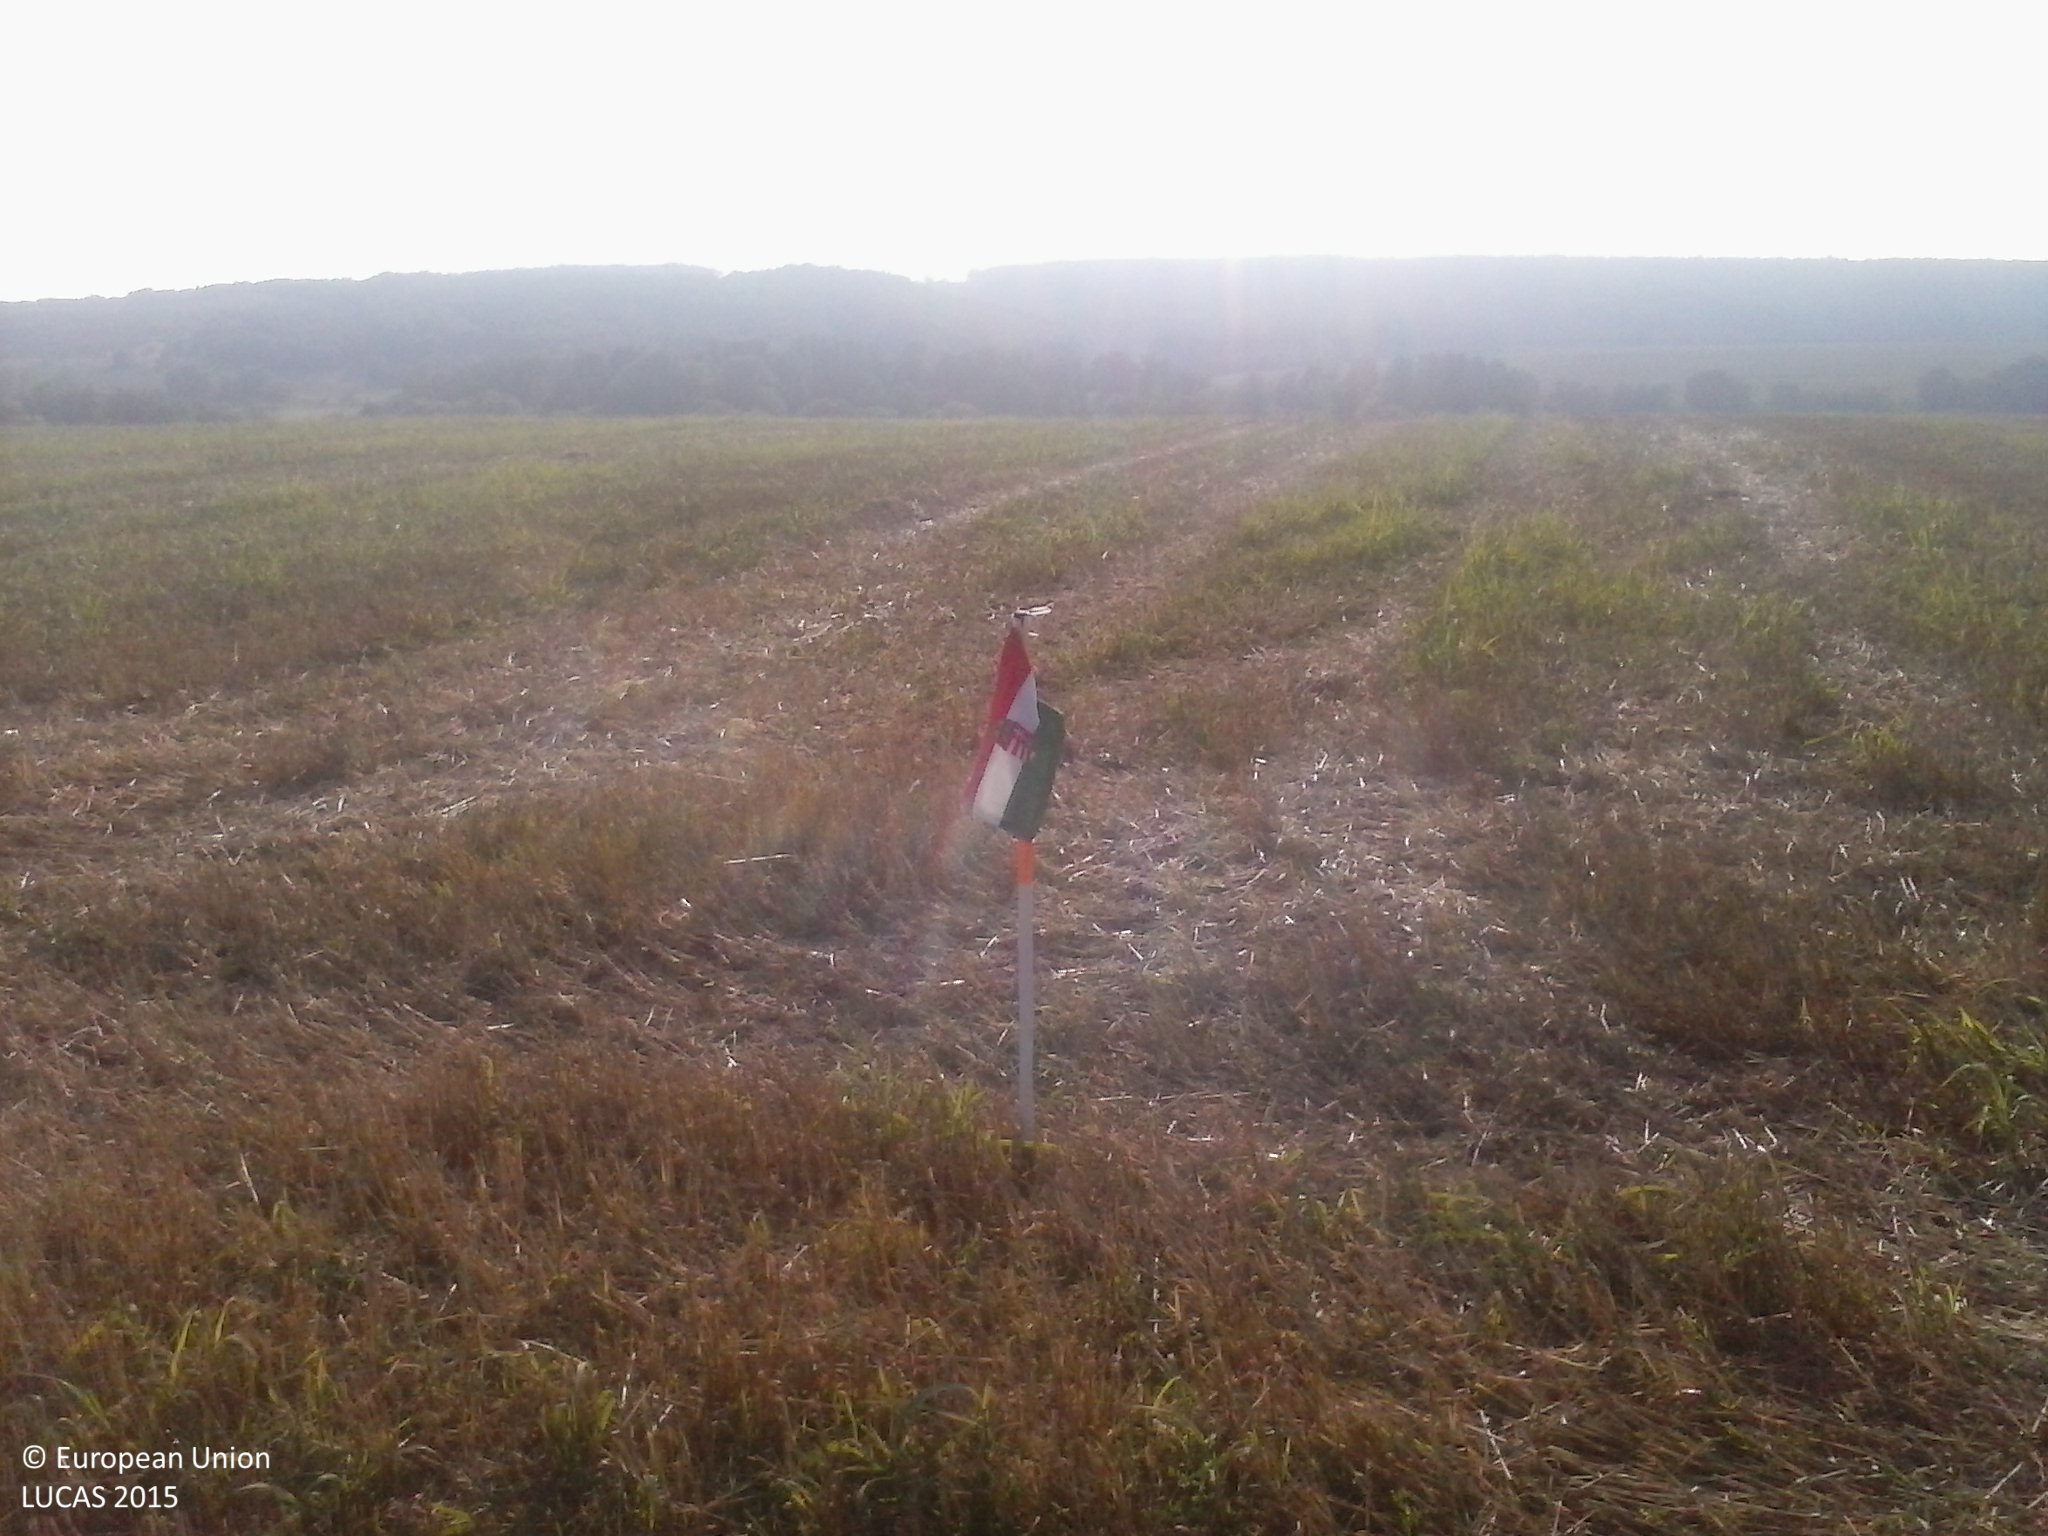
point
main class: Cropland
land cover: Common wheat
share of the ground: > 75 %
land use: Agriculture (excluding fallow land and kitchen gardens)
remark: Harvested field
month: August
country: HU
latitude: 46.1414
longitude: 17.7593
